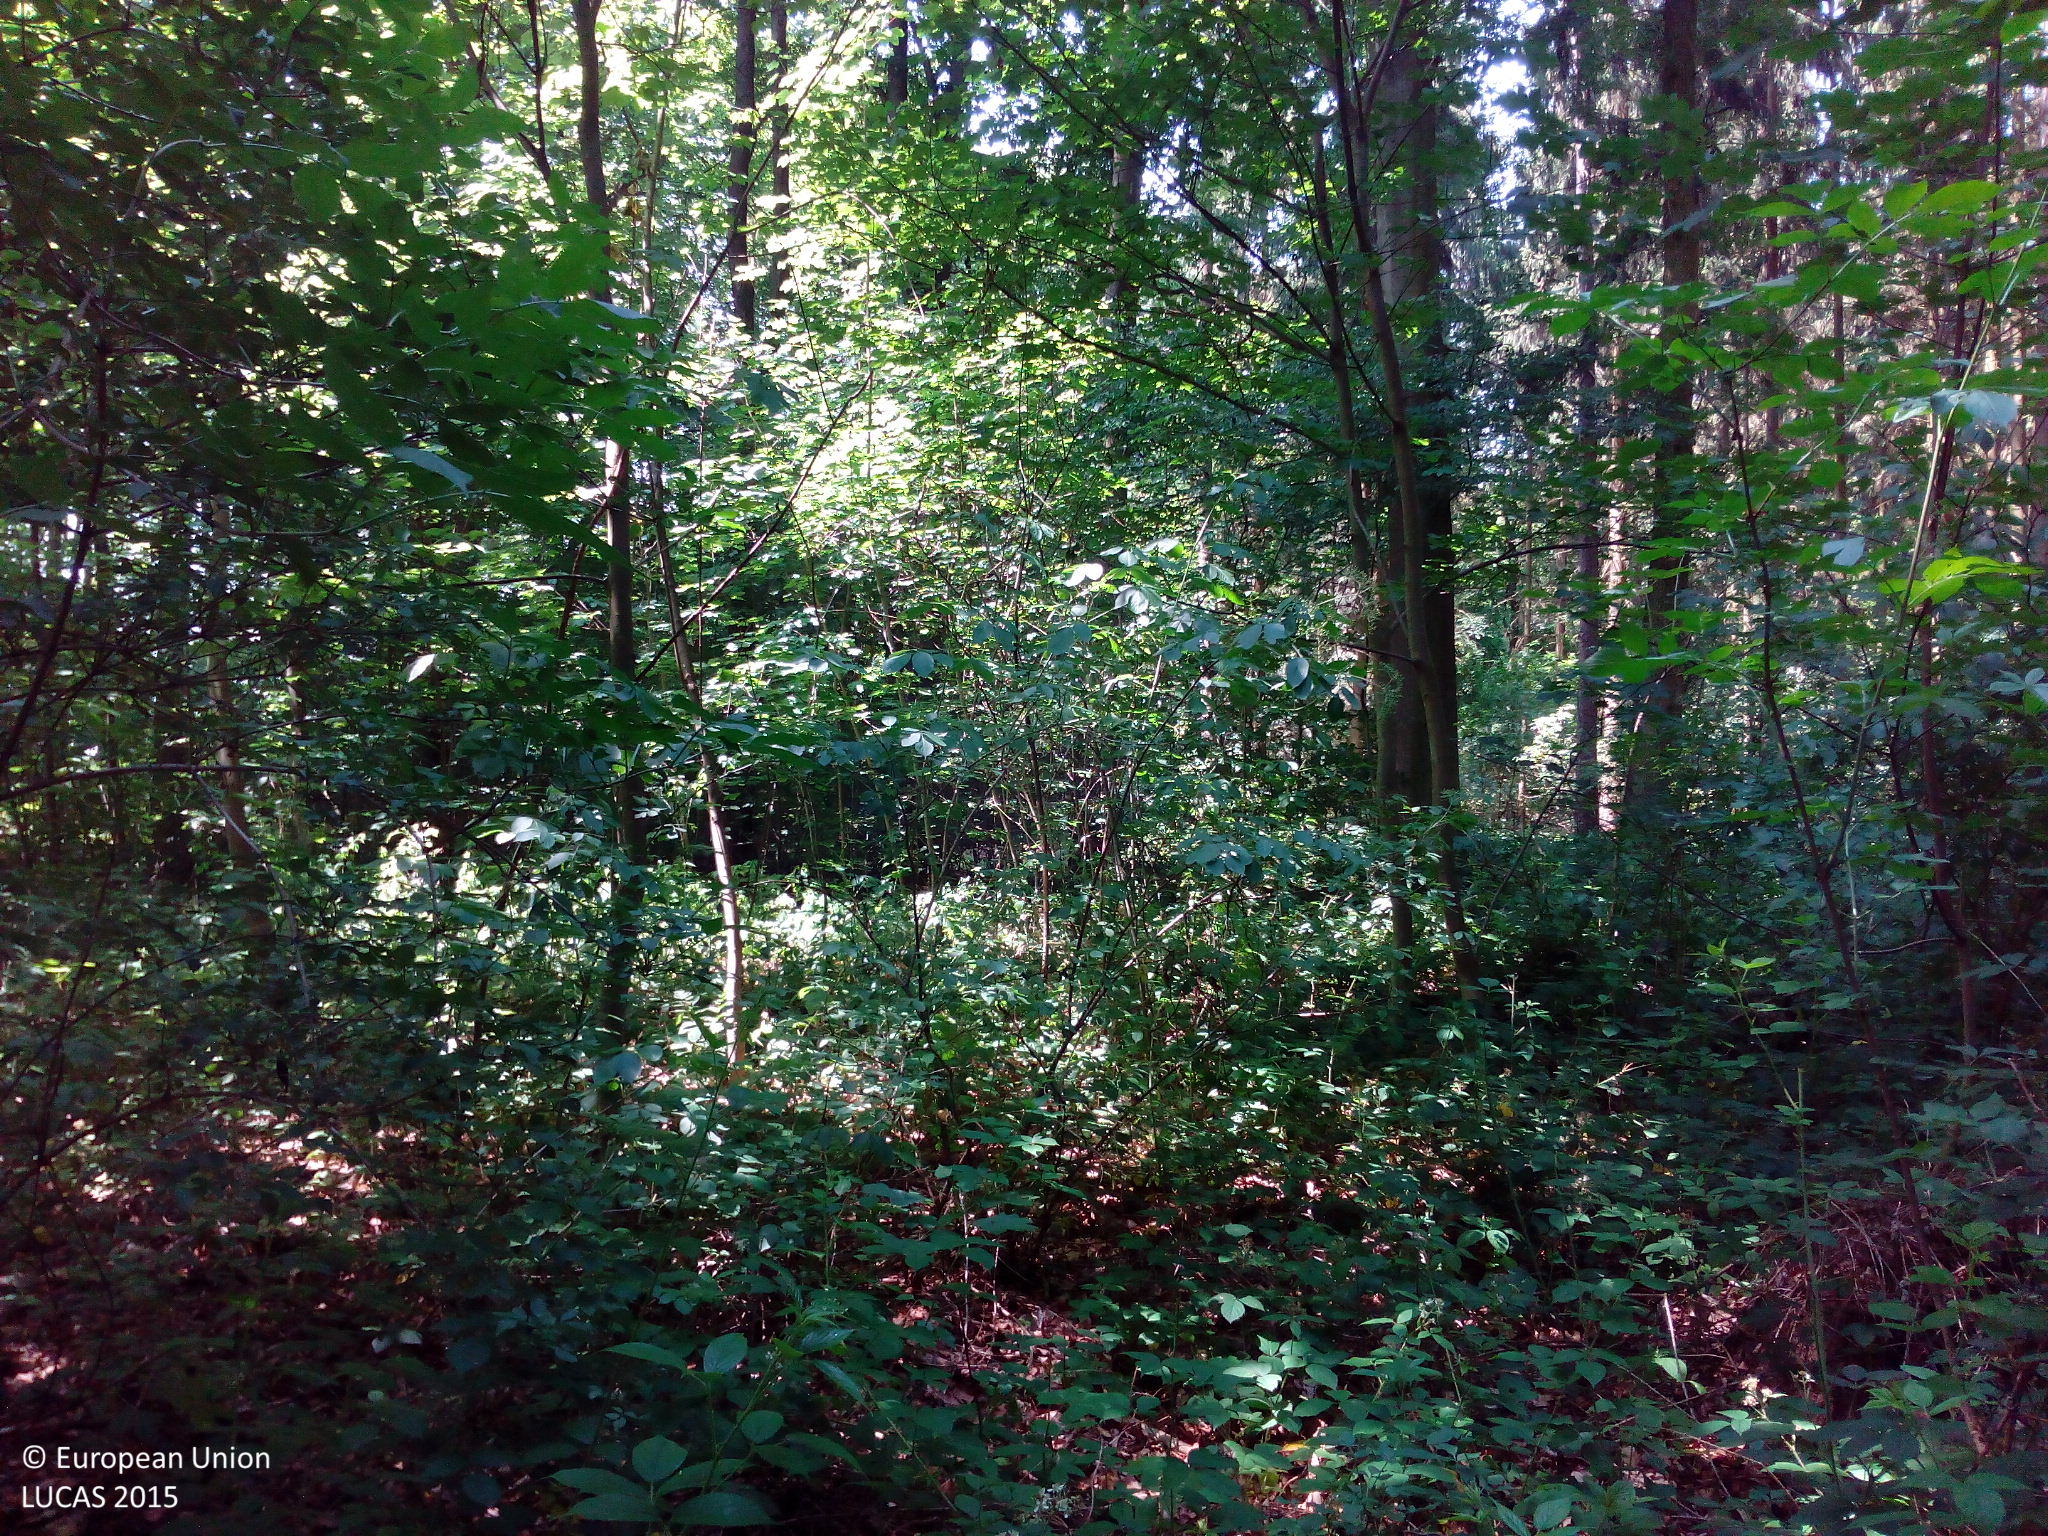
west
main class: Woodland
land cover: Pine dominated mixed woodland
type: hemiboreal forest and nemoral coniferous forest and mixed broadleaved-coniferous forest
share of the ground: > 75 %
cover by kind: broadleaved forest trees 65 %, coniferous forest trees 25 %, shrubs 5 %, herbaceous plants 5 %
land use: Forestry
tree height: > 5 m
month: July
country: DE
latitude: 49.5547
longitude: 9.9033
